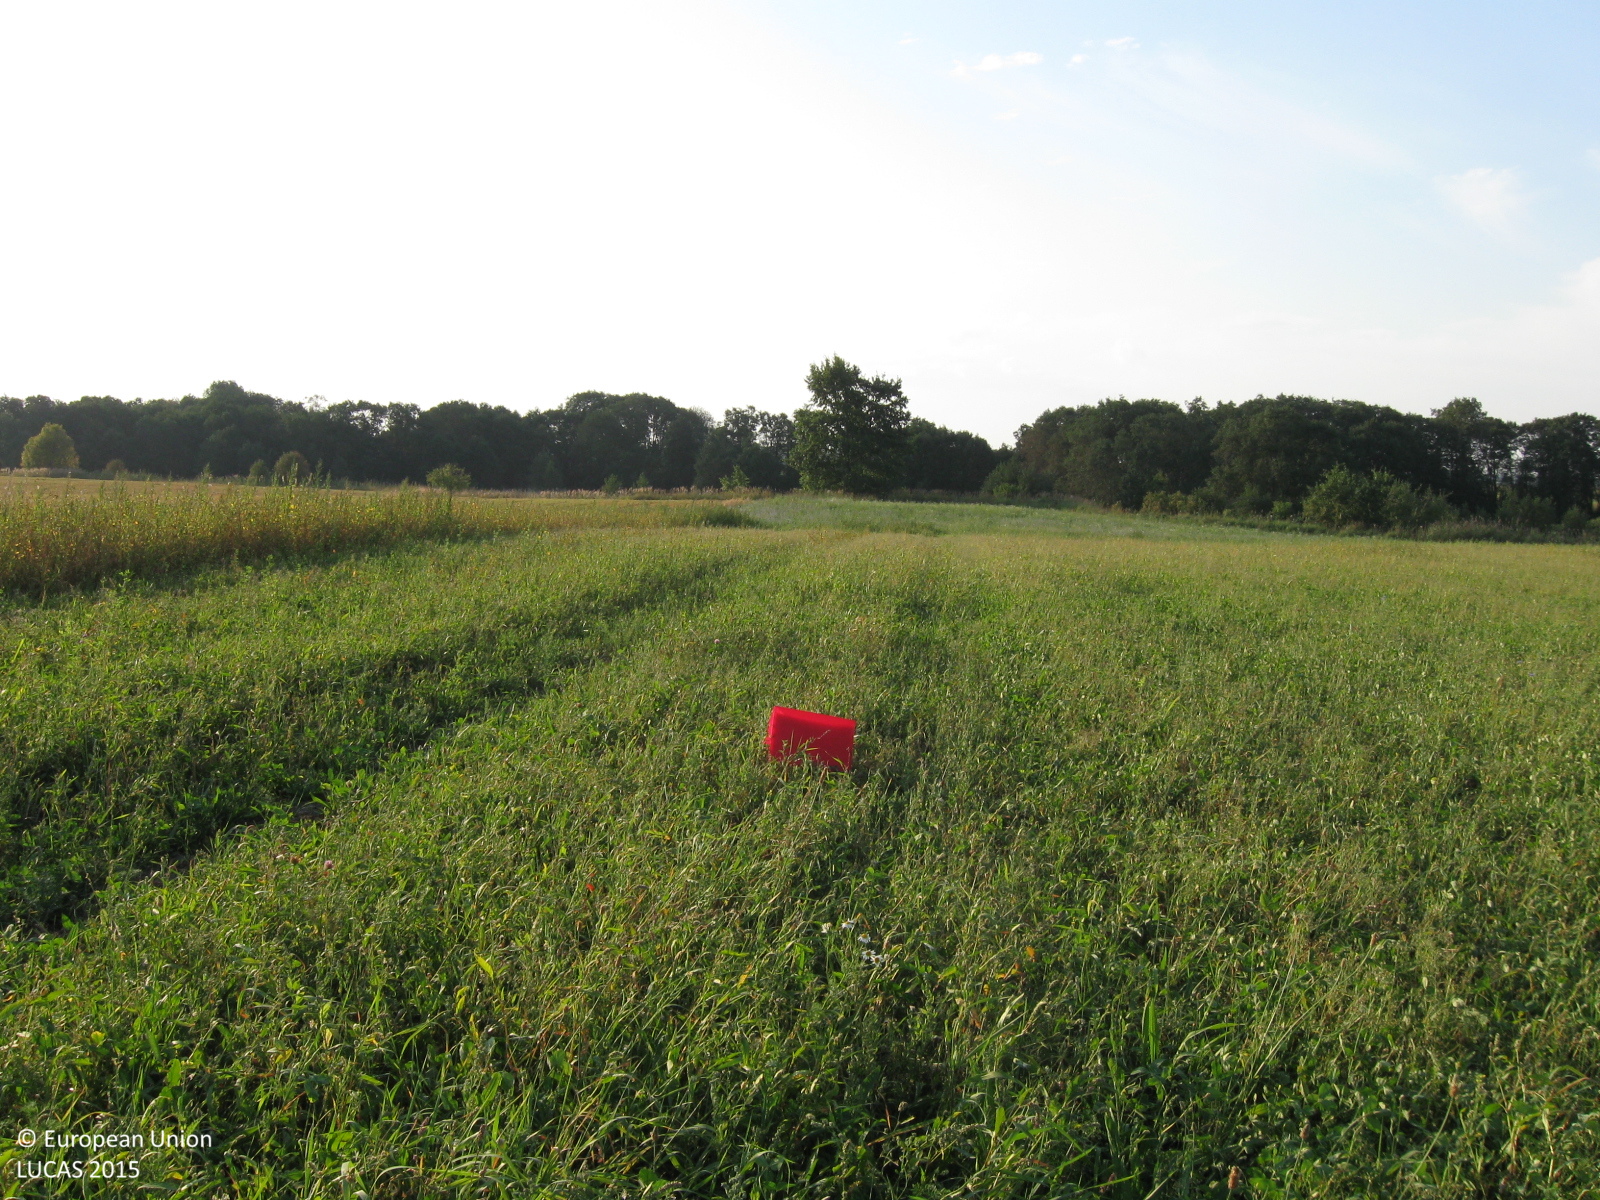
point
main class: Cropland
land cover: Other leguminous and mixtures for fodder
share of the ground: > 75 %
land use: Agriculture (excluding fallow land and kitchen gardens)
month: August
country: LT
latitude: 55.3581
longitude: 22.8282
